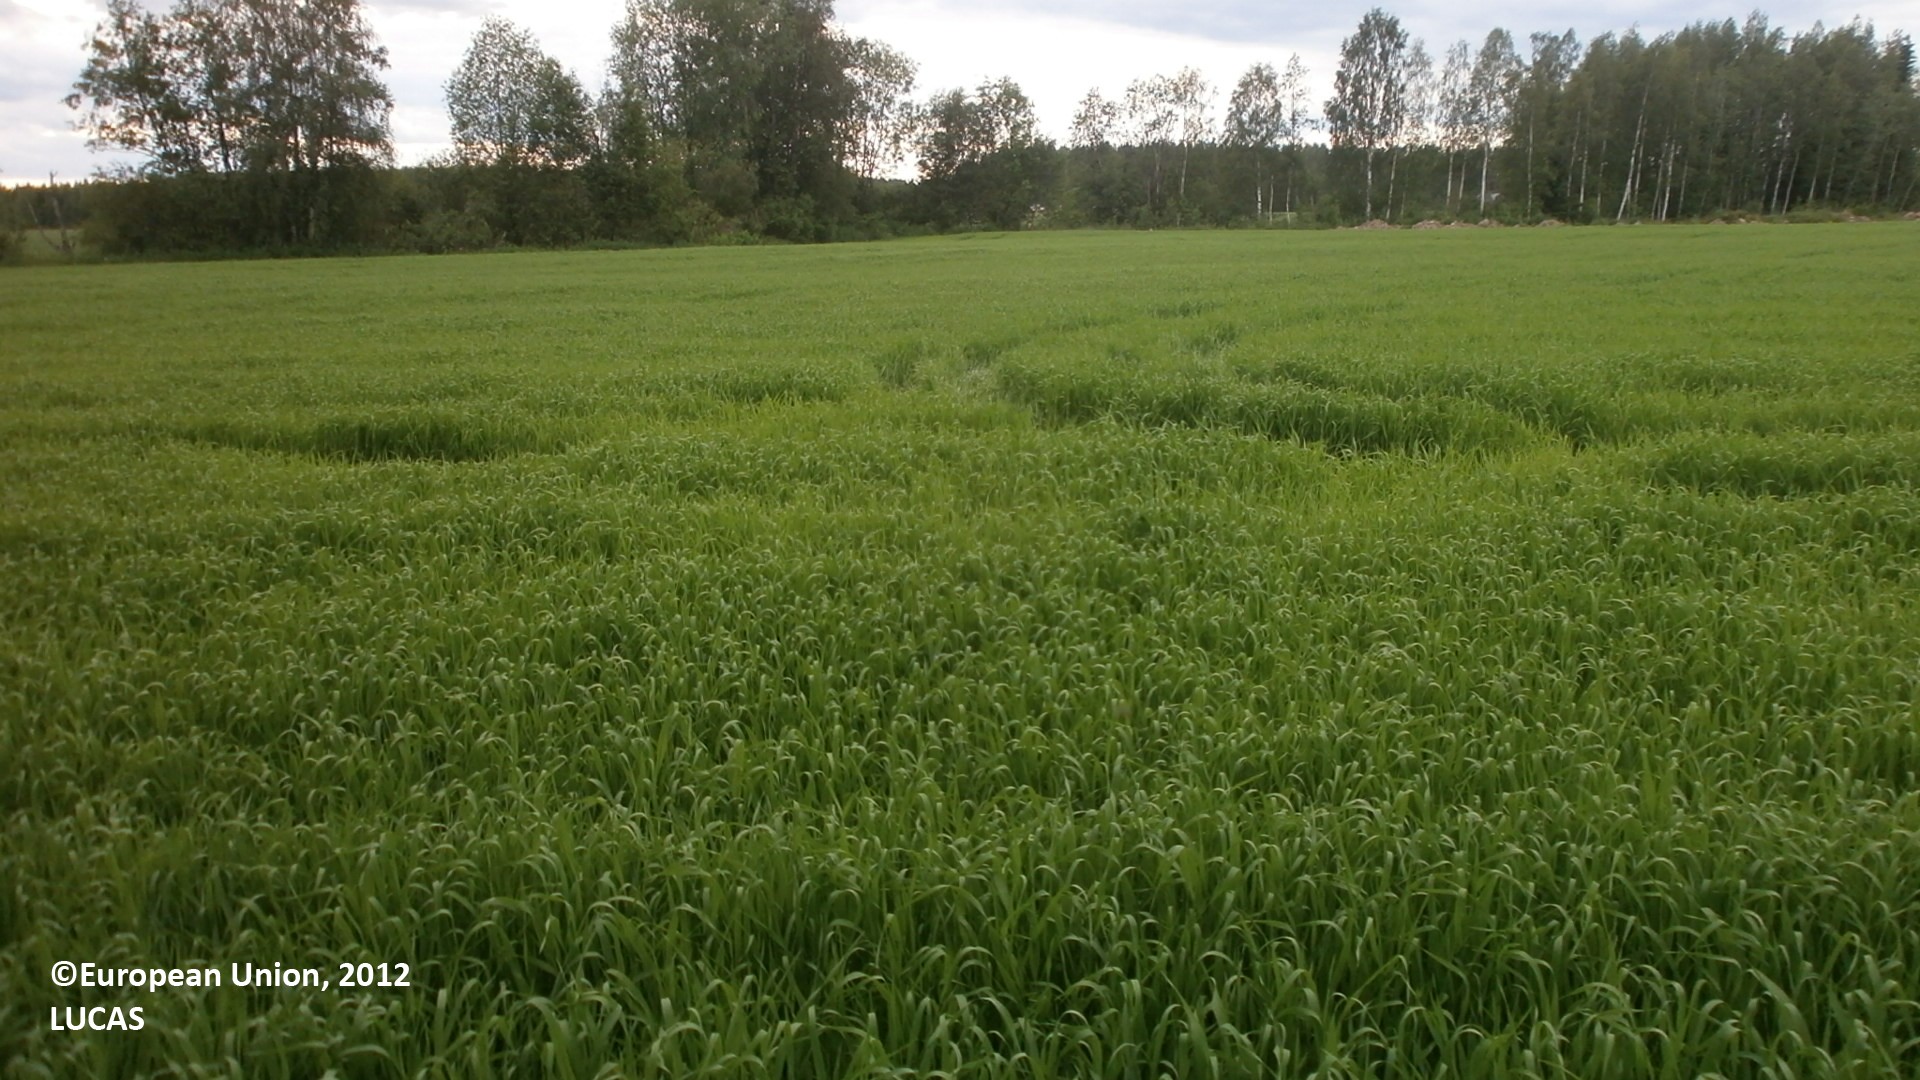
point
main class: Cropland
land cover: Barley
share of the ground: > 75 %
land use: Agriculture (excluding fallow land and kitchen gardens)
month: July
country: FI
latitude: 63.9821
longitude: 24.7297
